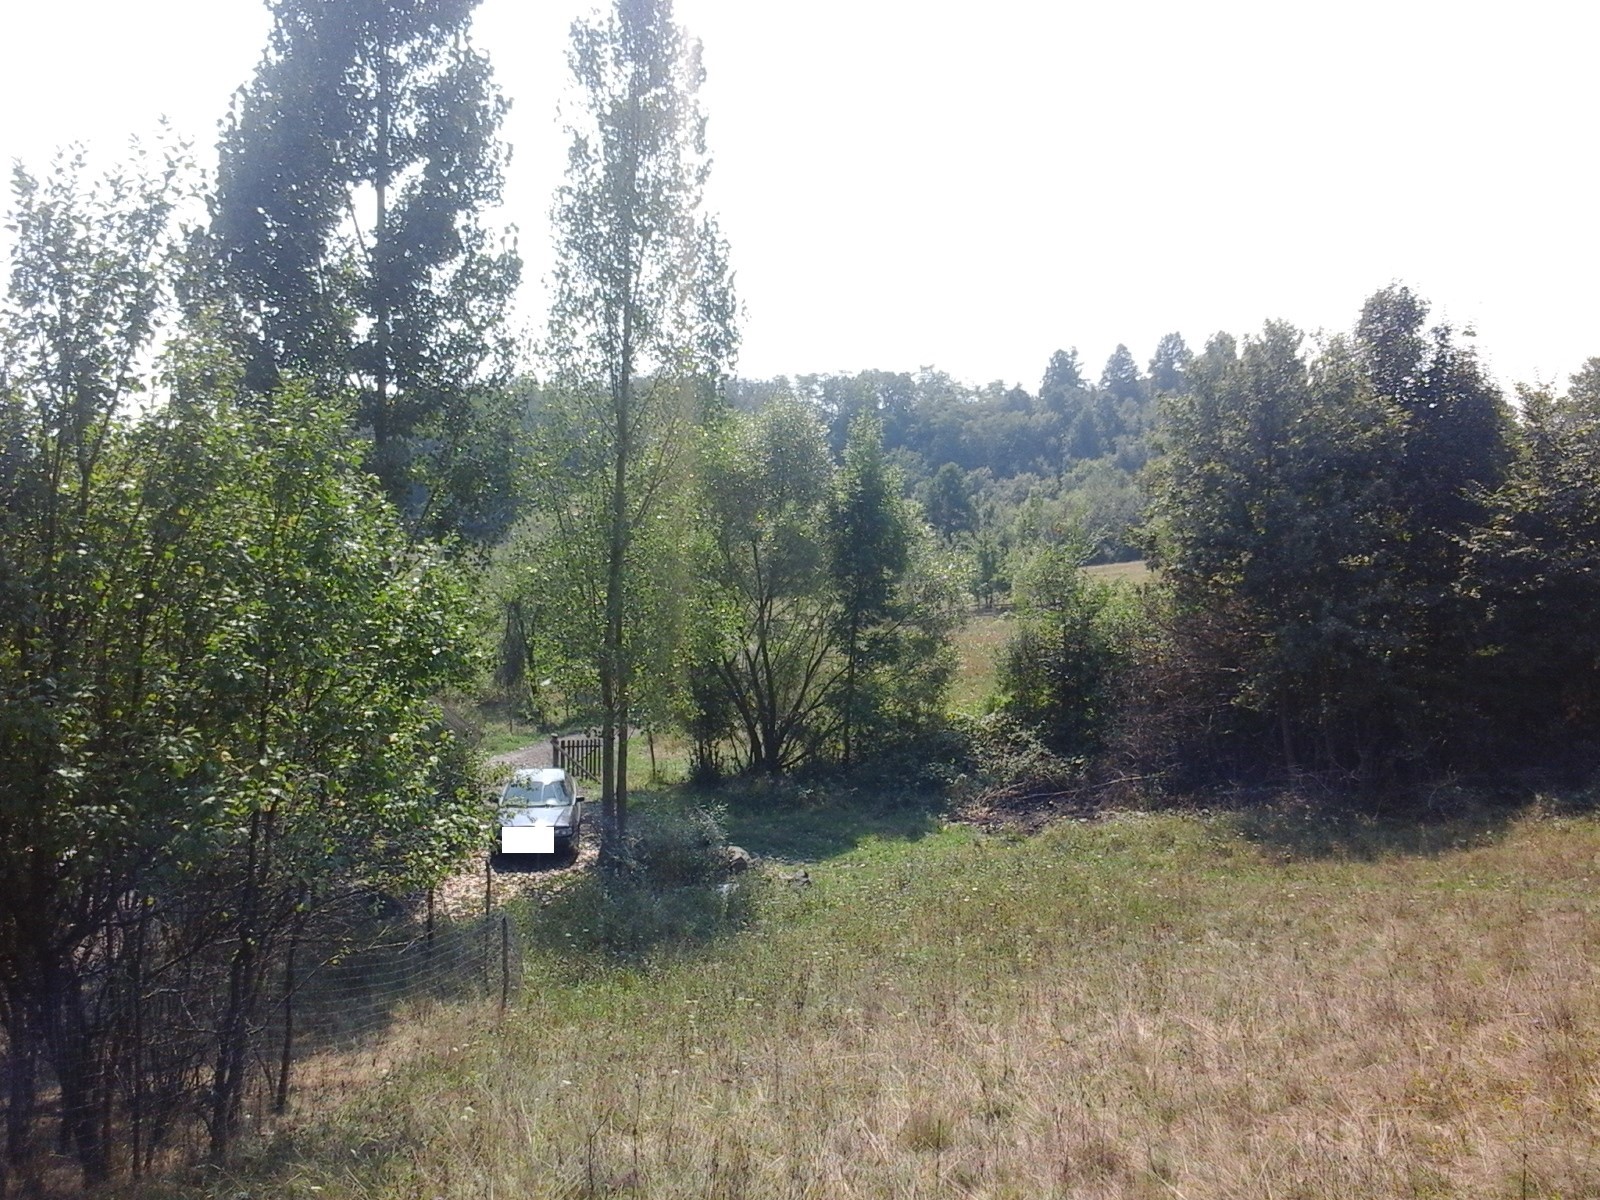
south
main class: Grassland
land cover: Grassland without tree/shrub cover
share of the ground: > 75 %
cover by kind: herbaceous plants 100 %
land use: Agriculture (excluding fallow land and kitchen gardens)
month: August
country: RO
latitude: 46.1844
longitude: 22.7630
